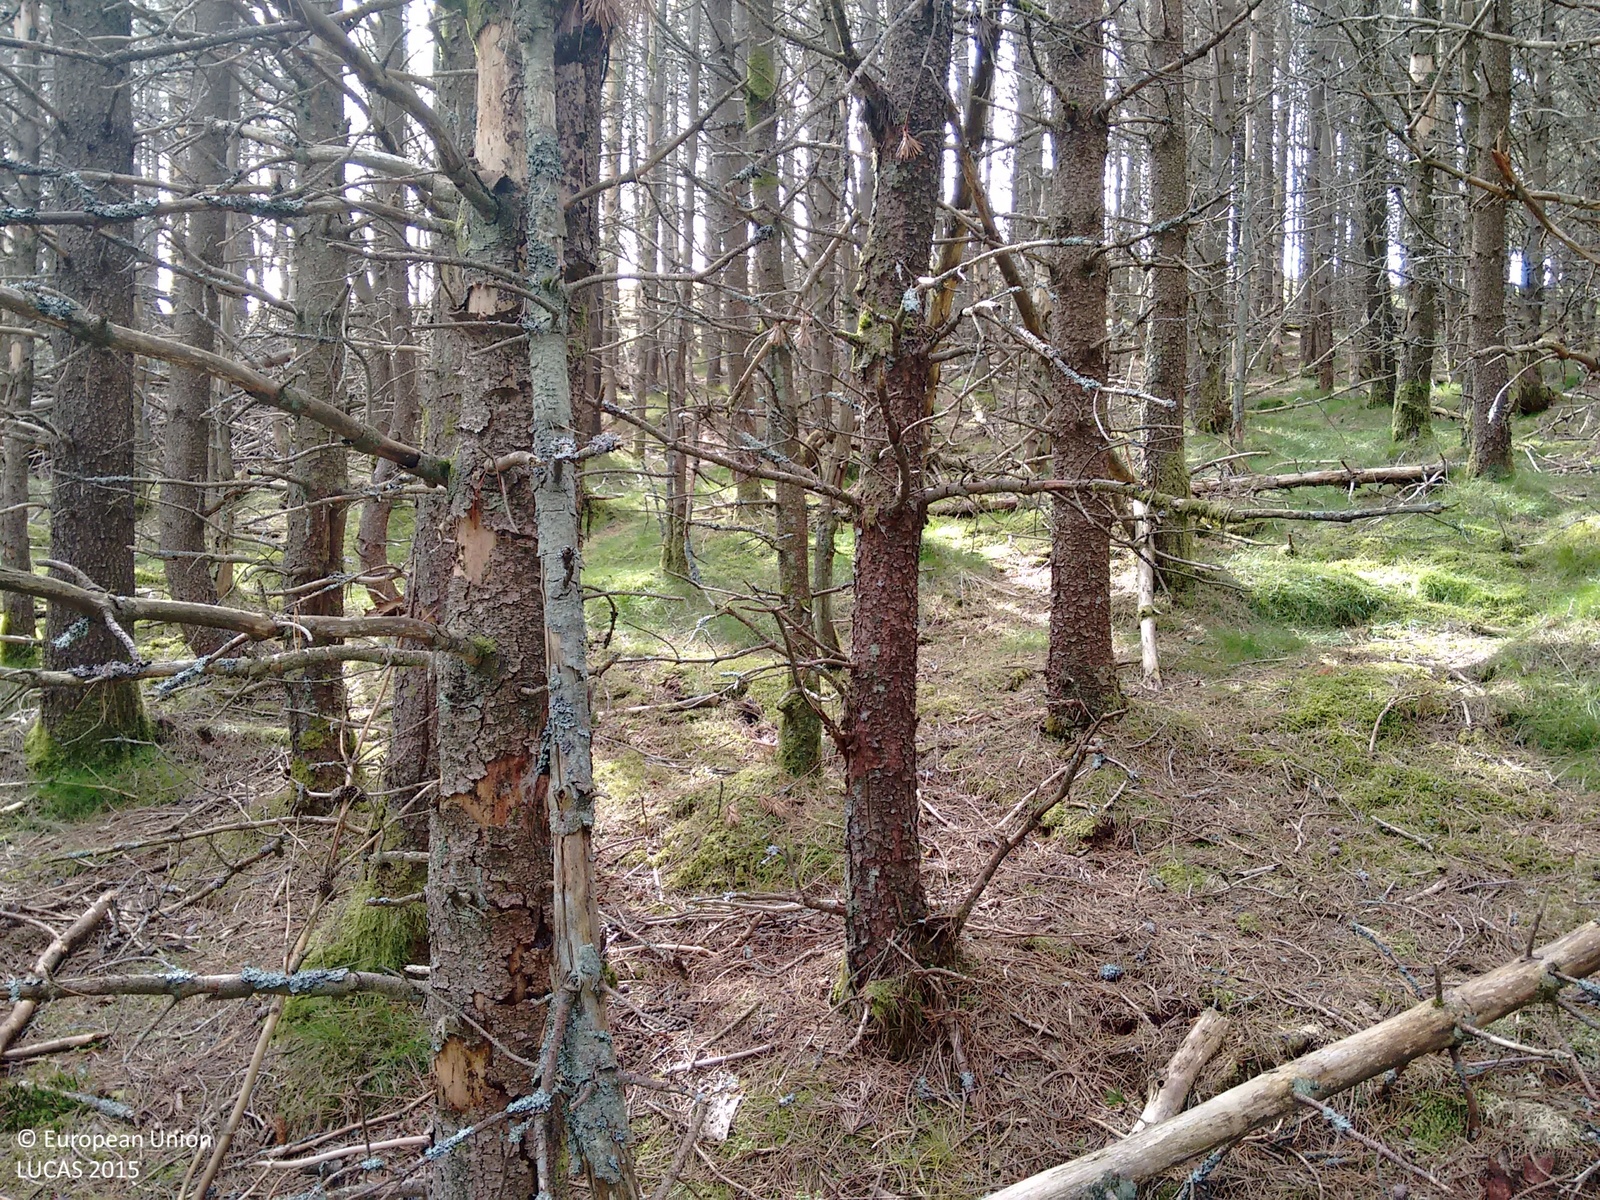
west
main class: Woodland
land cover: Pine dominated coniferous woodland
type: exotic forest
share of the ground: > 75 %
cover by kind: coniferous forest trees 90 %, herbaceous plants 5 %, lichens and mosses 5 %
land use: Forestry
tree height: > 5 m
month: May
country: GB
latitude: 56.8203
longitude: -3.1579
